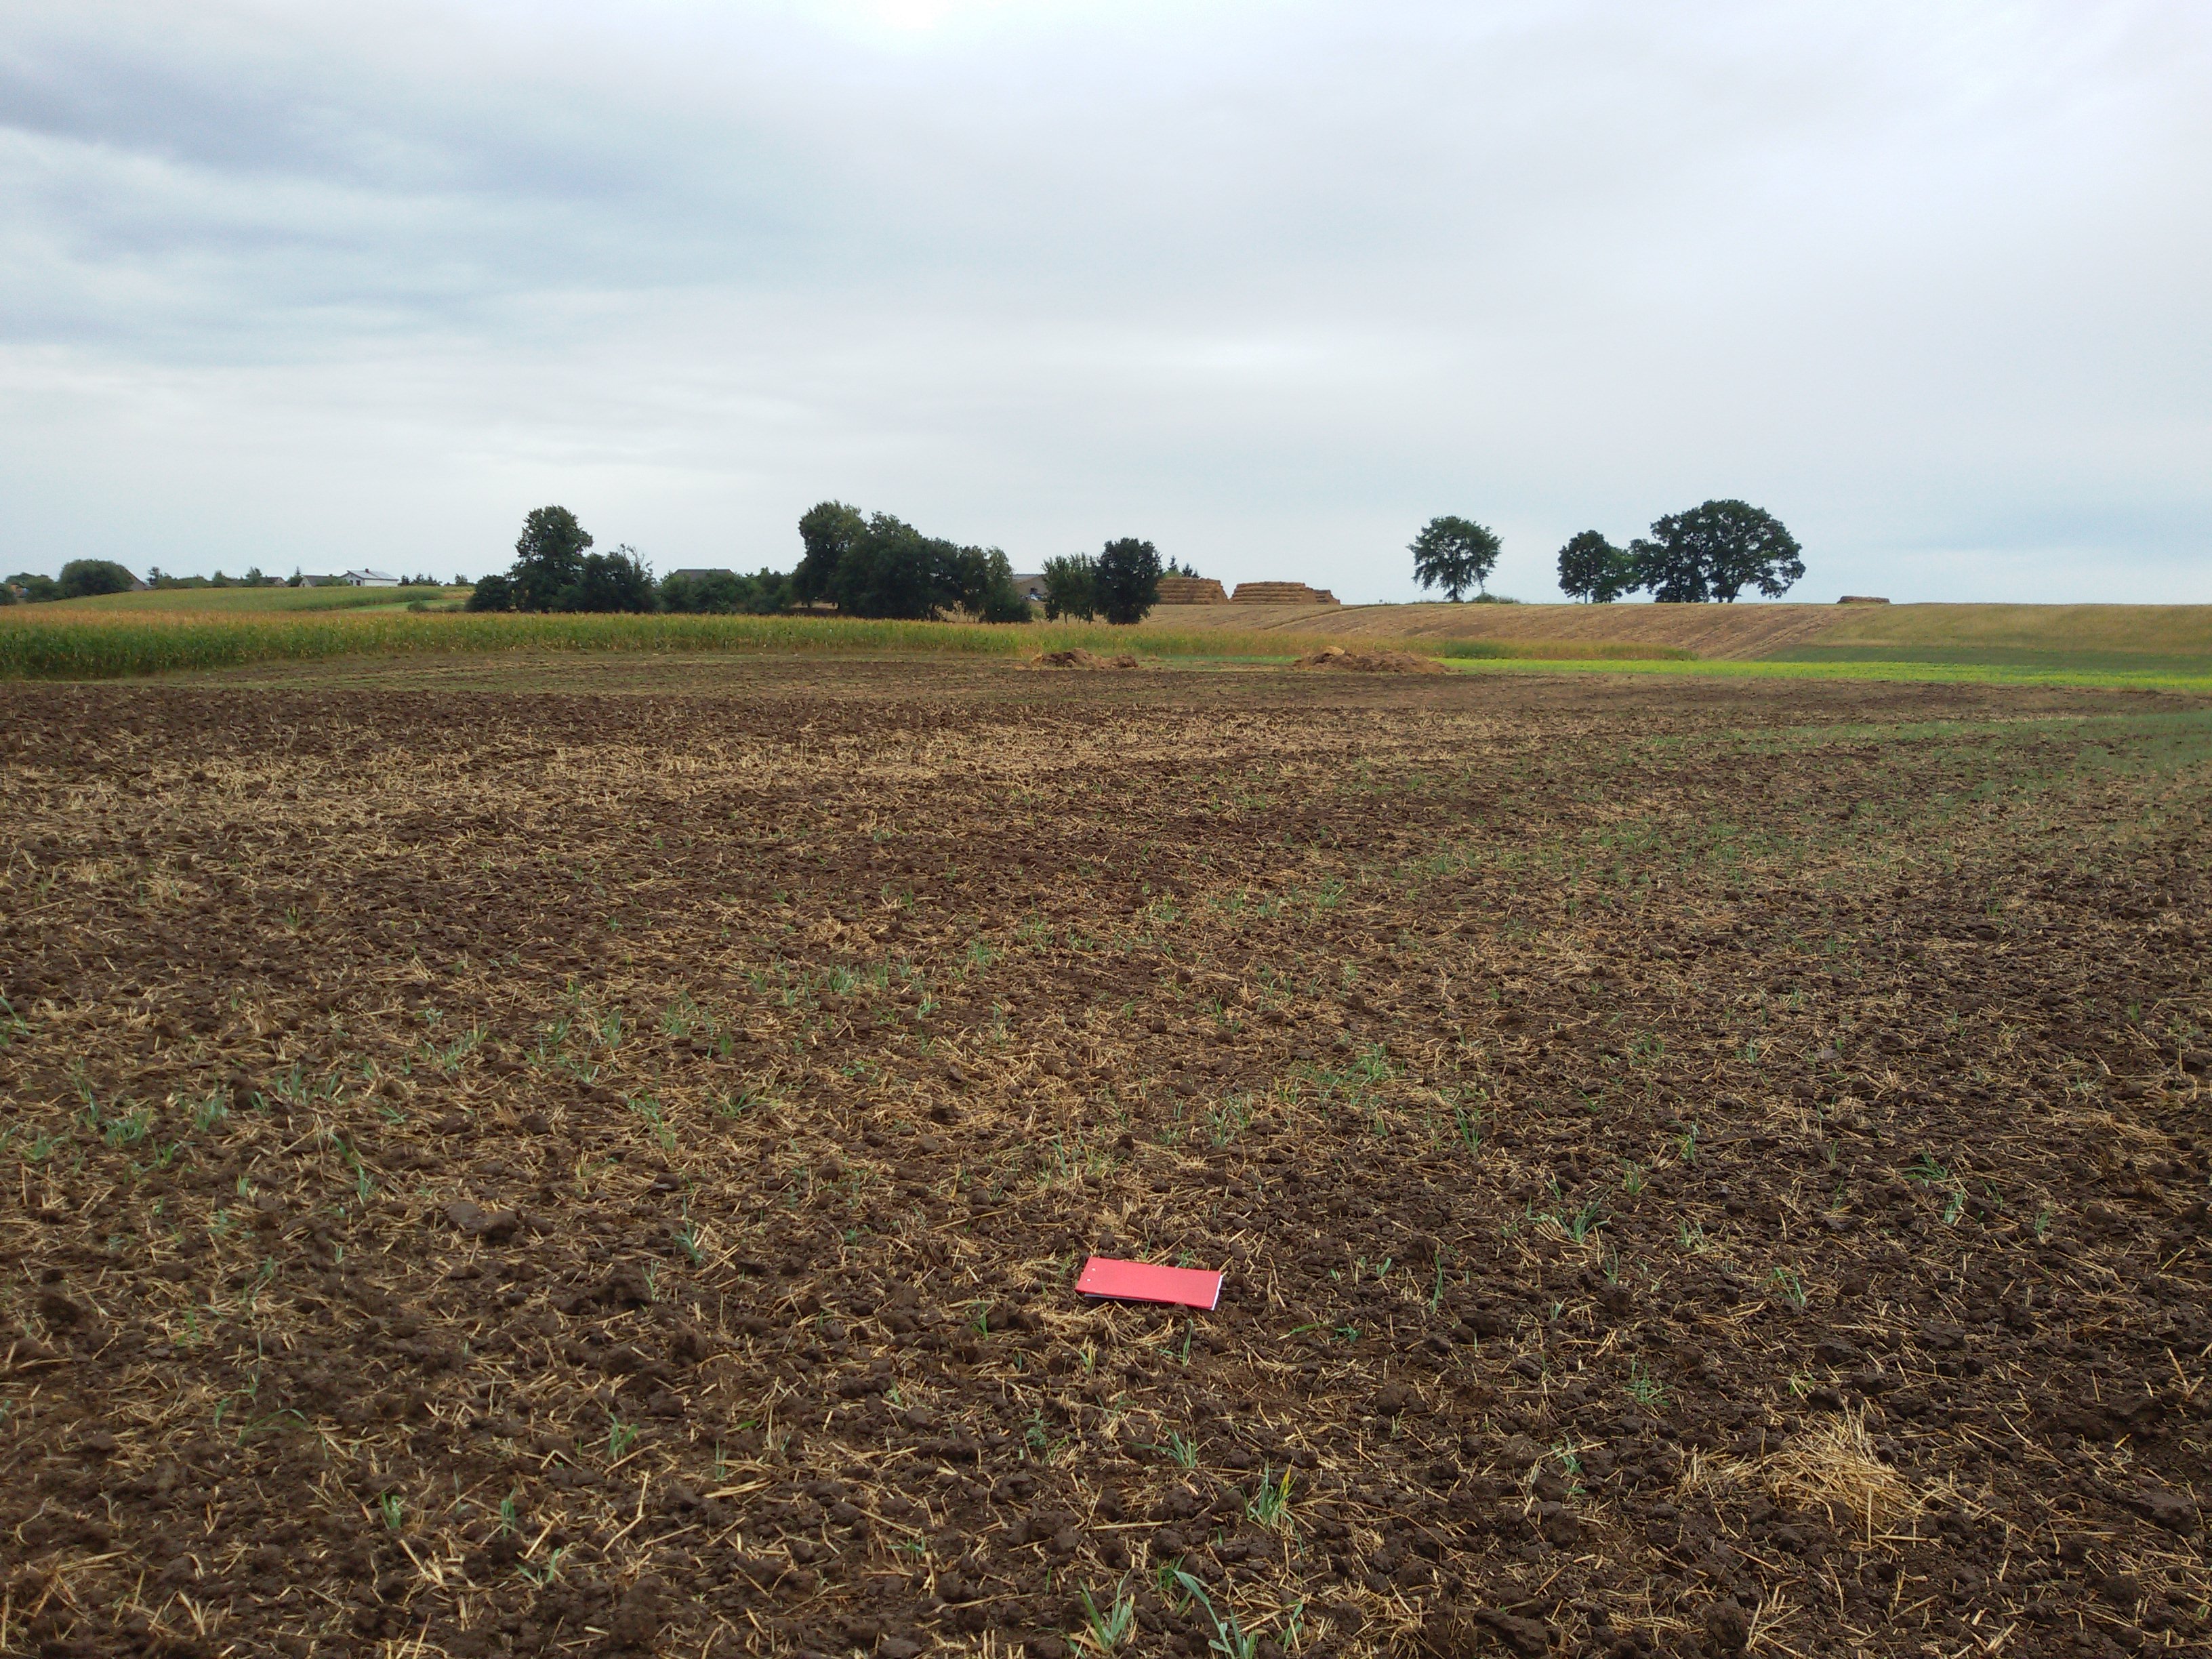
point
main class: Cropland
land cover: Rye
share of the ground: 25 - 50 %
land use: Agriculture (excluding fallow land and kitchen gardens)
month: August
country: PL
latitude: 51.9325
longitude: 17.9125
